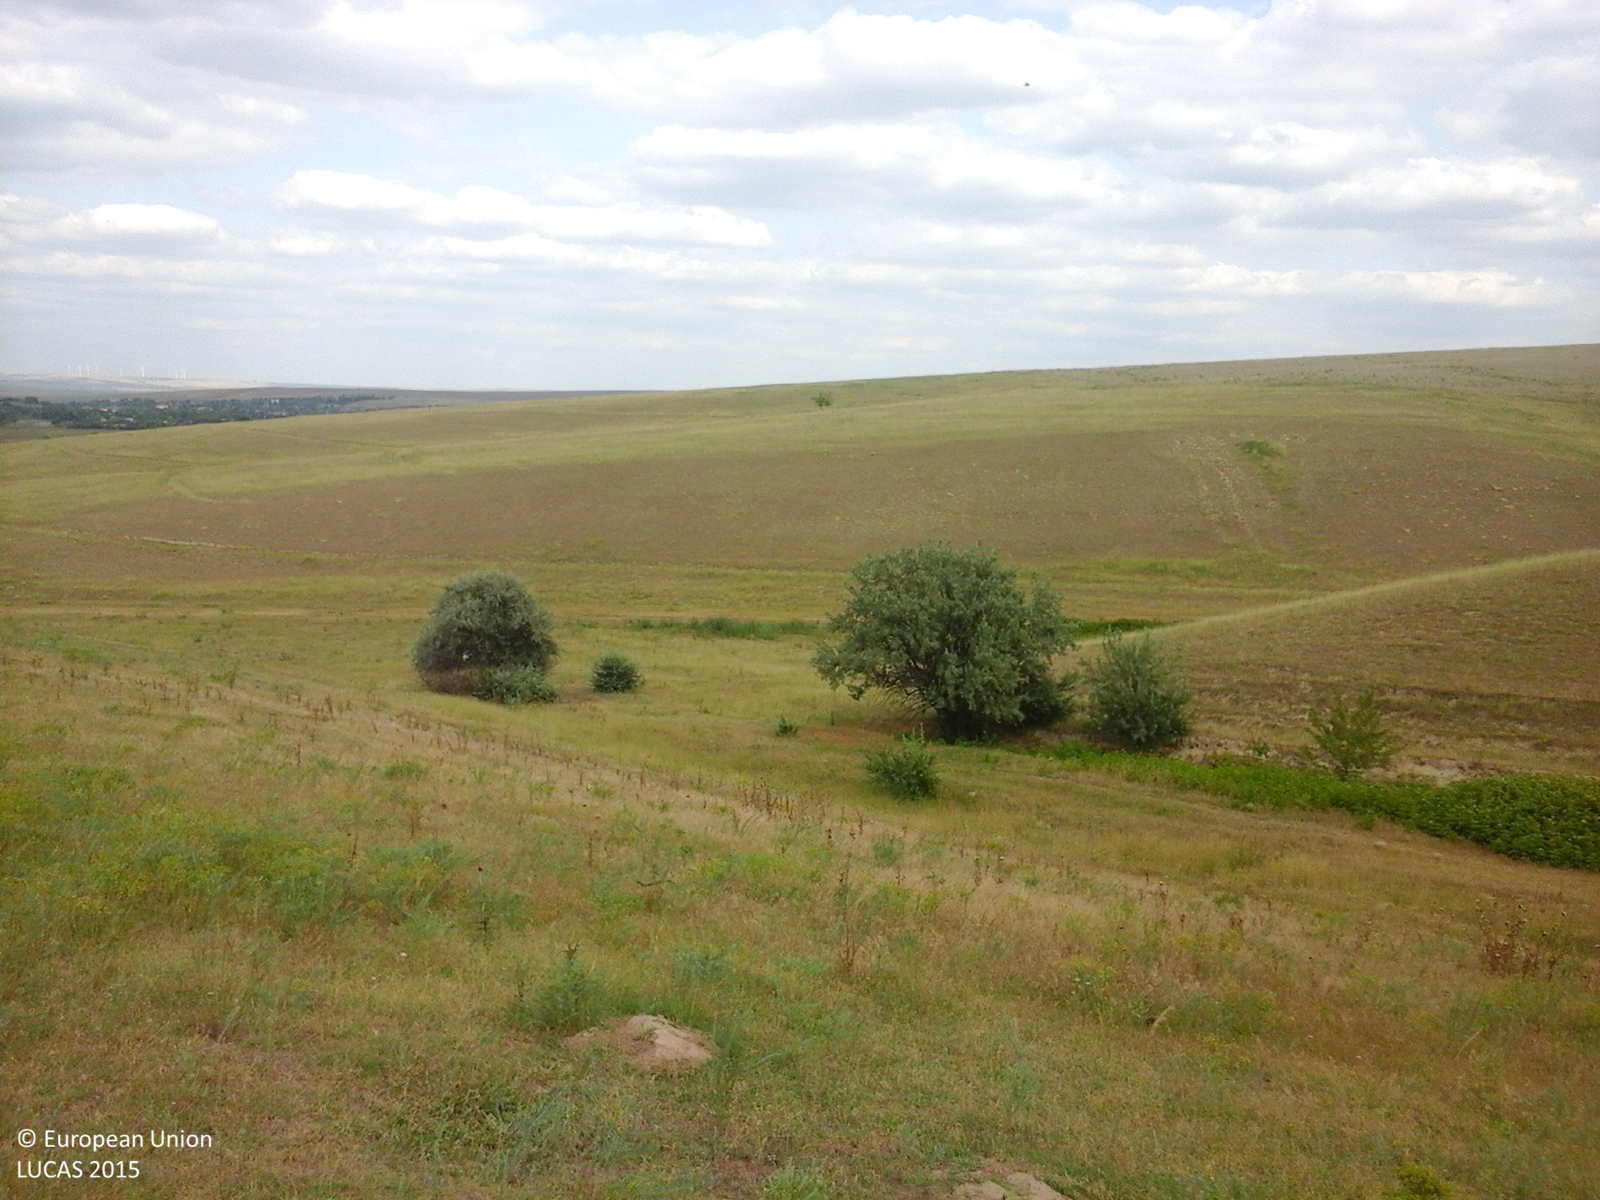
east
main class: Grassland
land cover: Grassland without tree/shrub cover
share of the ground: > 75 %
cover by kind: herbaceous plants 100 %
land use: Agriculture (excluding fallow land and kitchen gardens)
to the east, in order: Grassland without tree/shrub cover; Grassland with sparse tree/shrub cover; Grassland without tree/shrub cover; Tracks; Grassland without tree/shrub cover
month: August
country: RO
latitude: 44.7118
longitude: 28.1264
